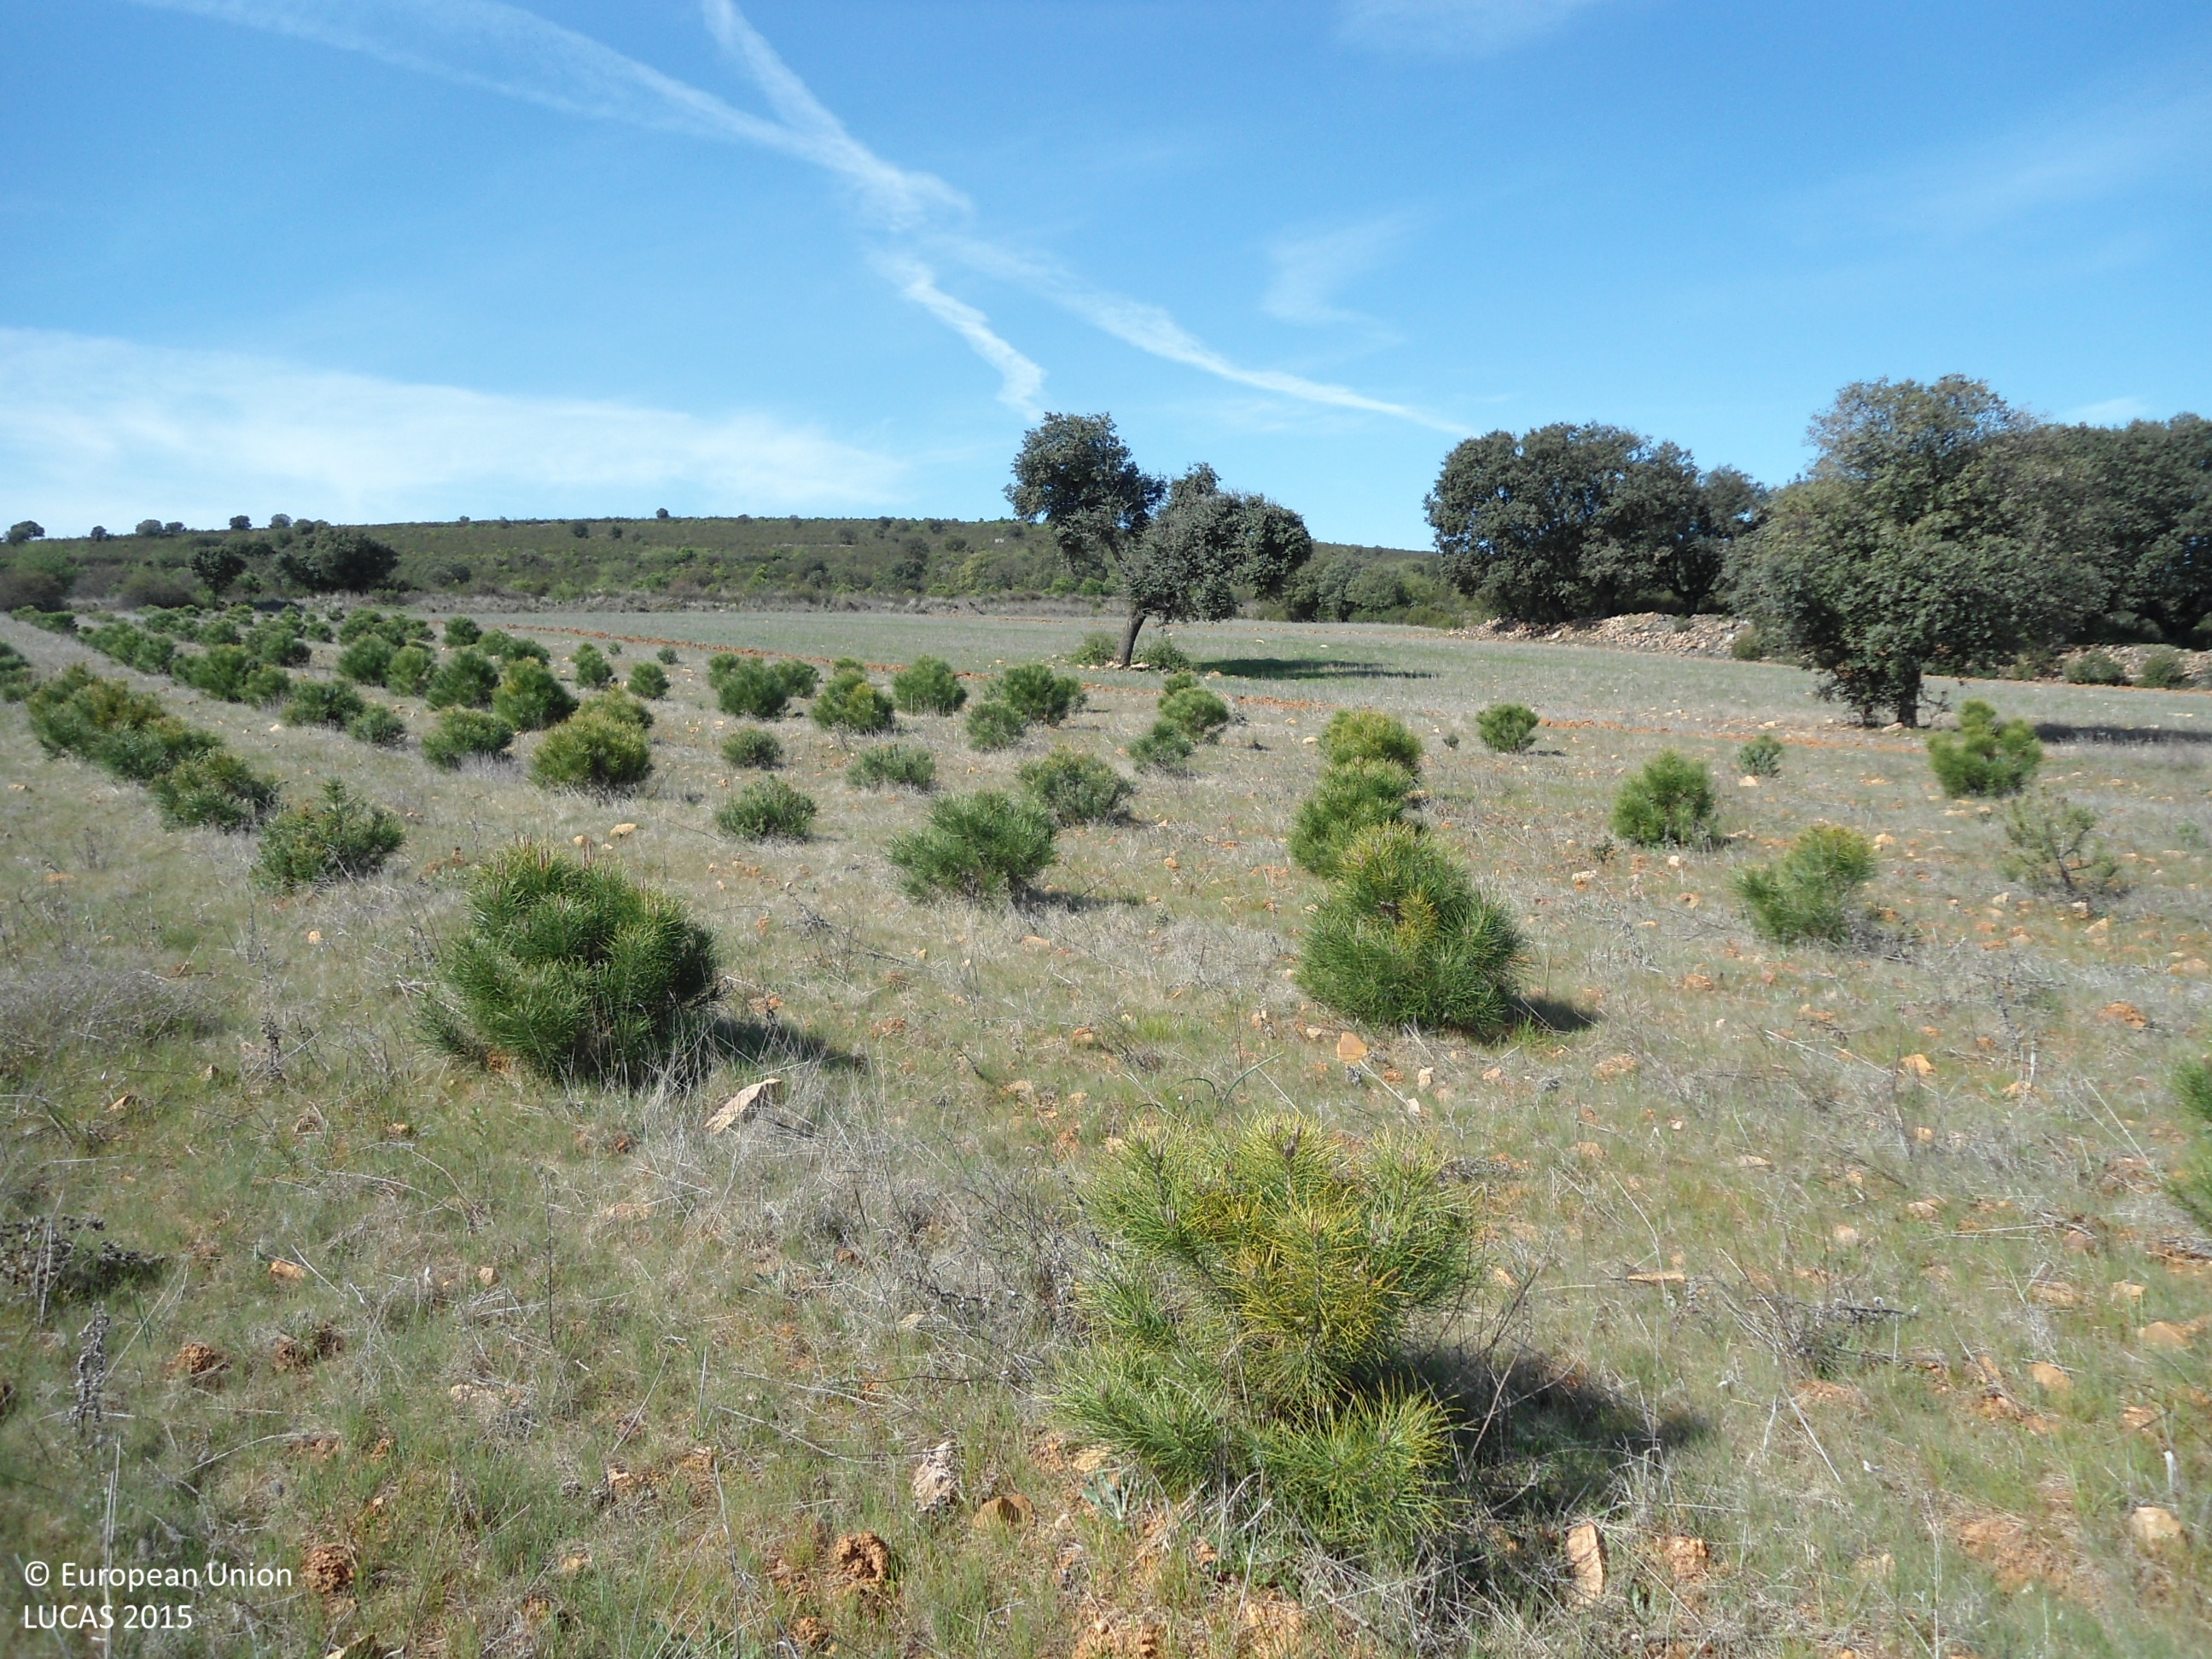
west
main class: Woodland
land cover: Pine dominated coniferous woodland
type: coniferous forest of the mediterranean region
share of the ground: 25 - 50 %
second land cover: Spontaneously vegetated surfaces
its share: 25 - 50 %
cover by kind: herbaceous plants 55 %, coniferous forest trees 45 %
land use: Forestry
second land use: Fallow land
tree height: < 5 m
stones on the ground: < 10 %
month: April
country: ES
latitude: 41.7057
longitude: -5.8709
